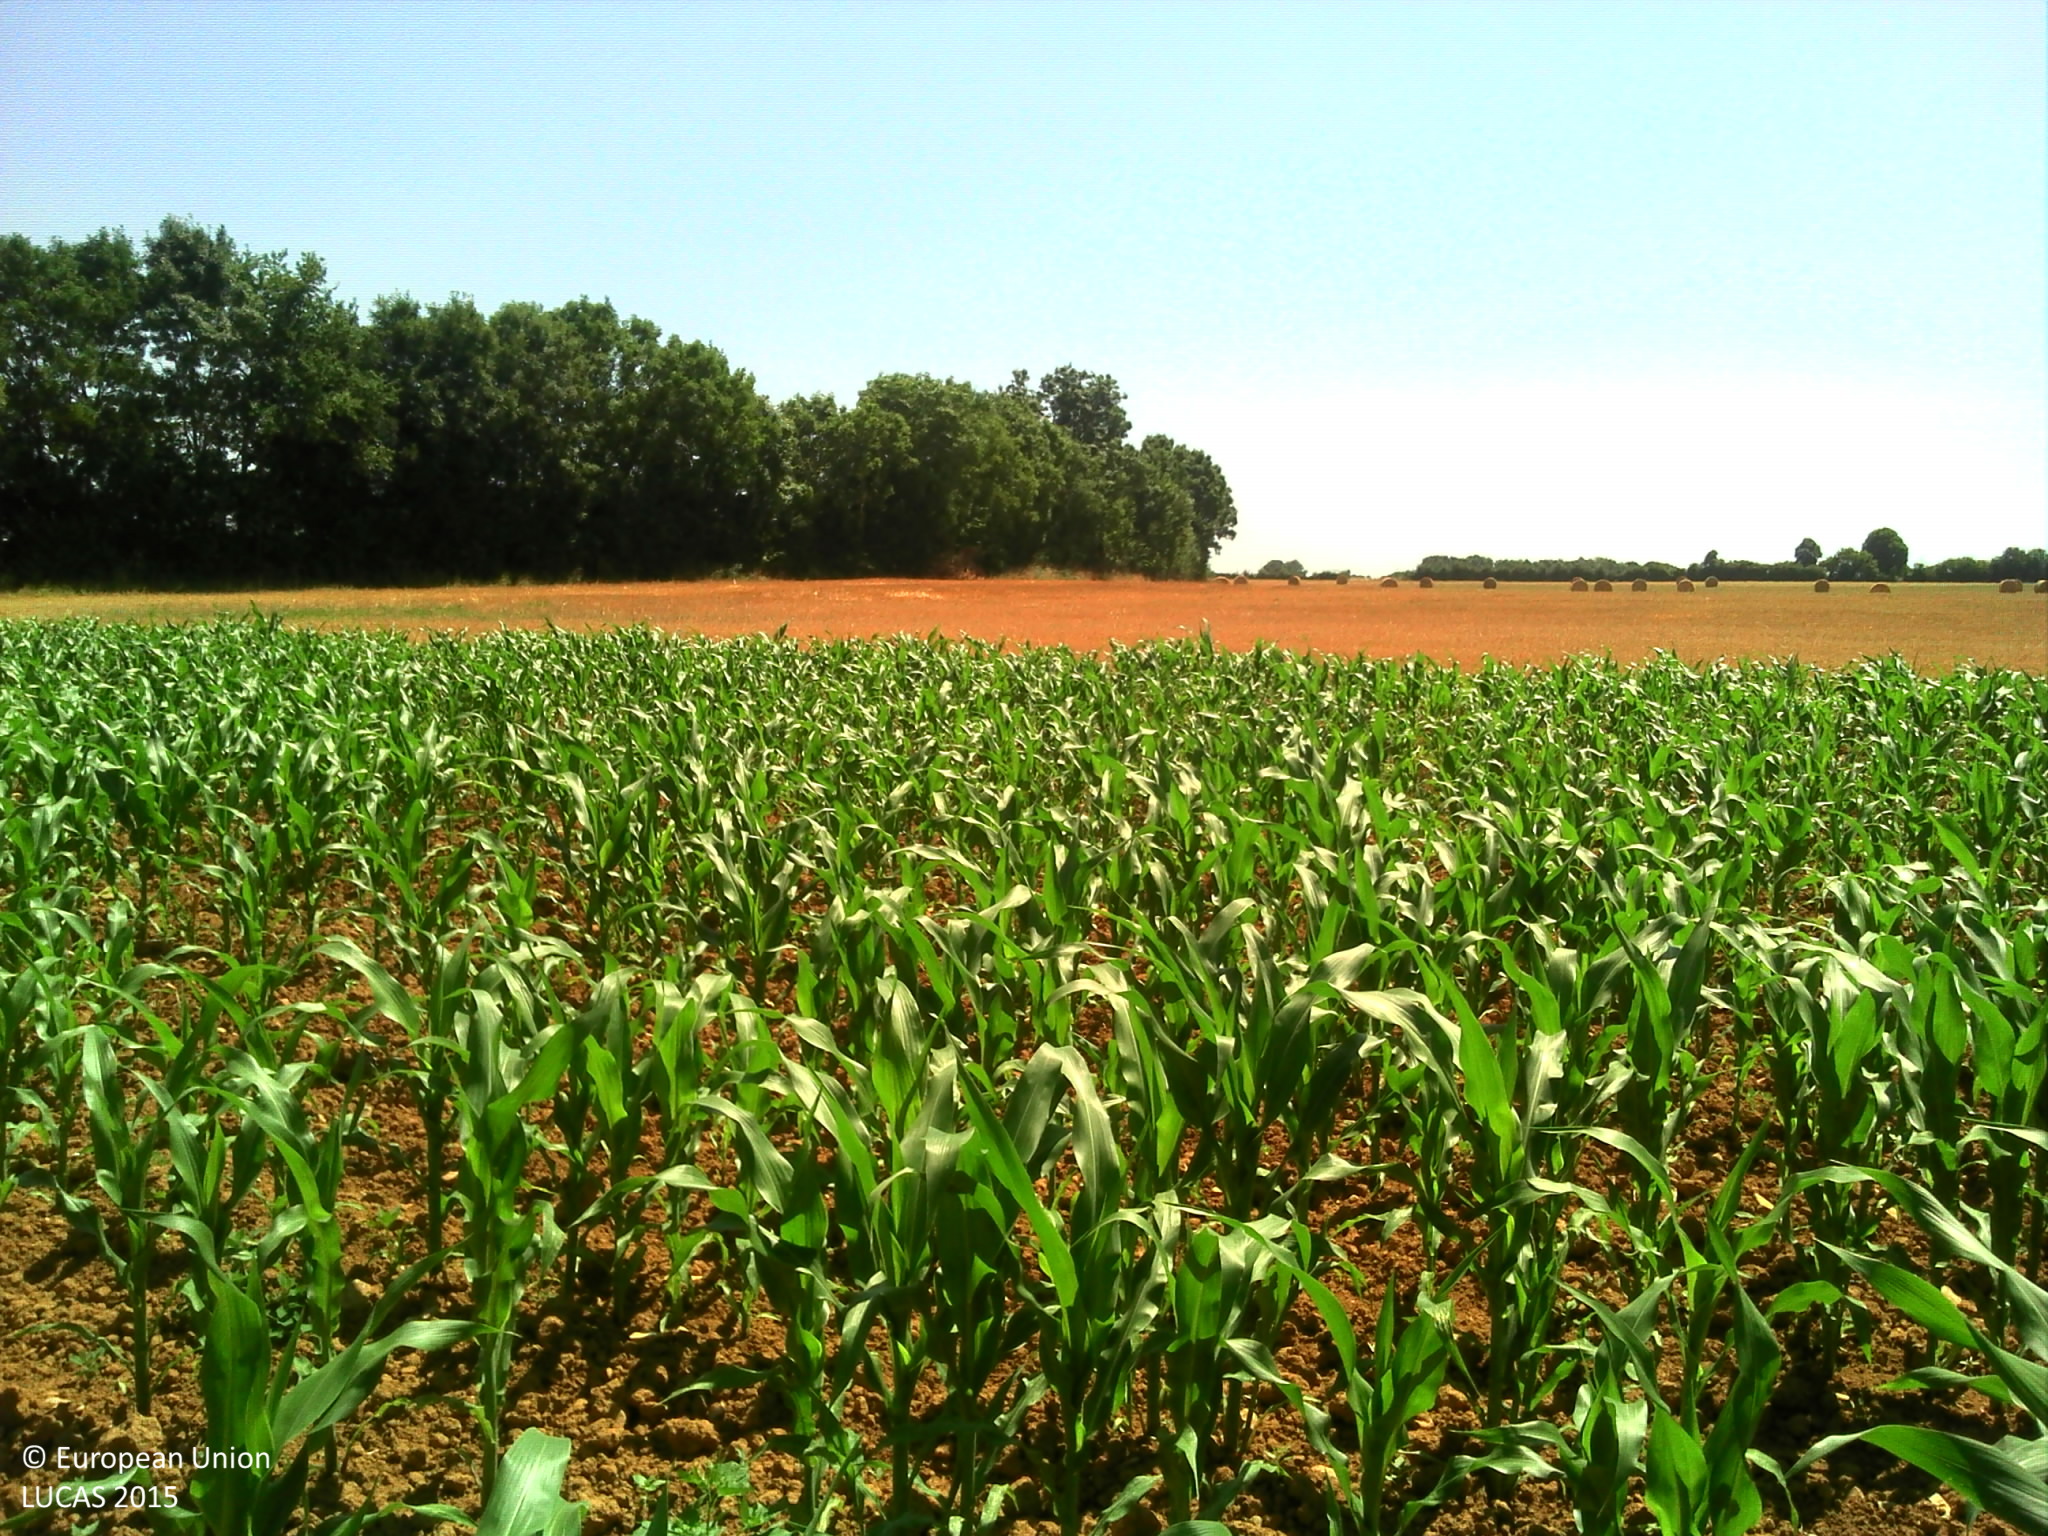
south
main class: Cropland
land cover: Maize
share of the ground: > 75 %
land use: Agriculture (excluding fallow land and kitchen gardens)
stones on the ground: < 10 %
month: July
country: FR
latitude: 46.4718
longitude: -1.3533
